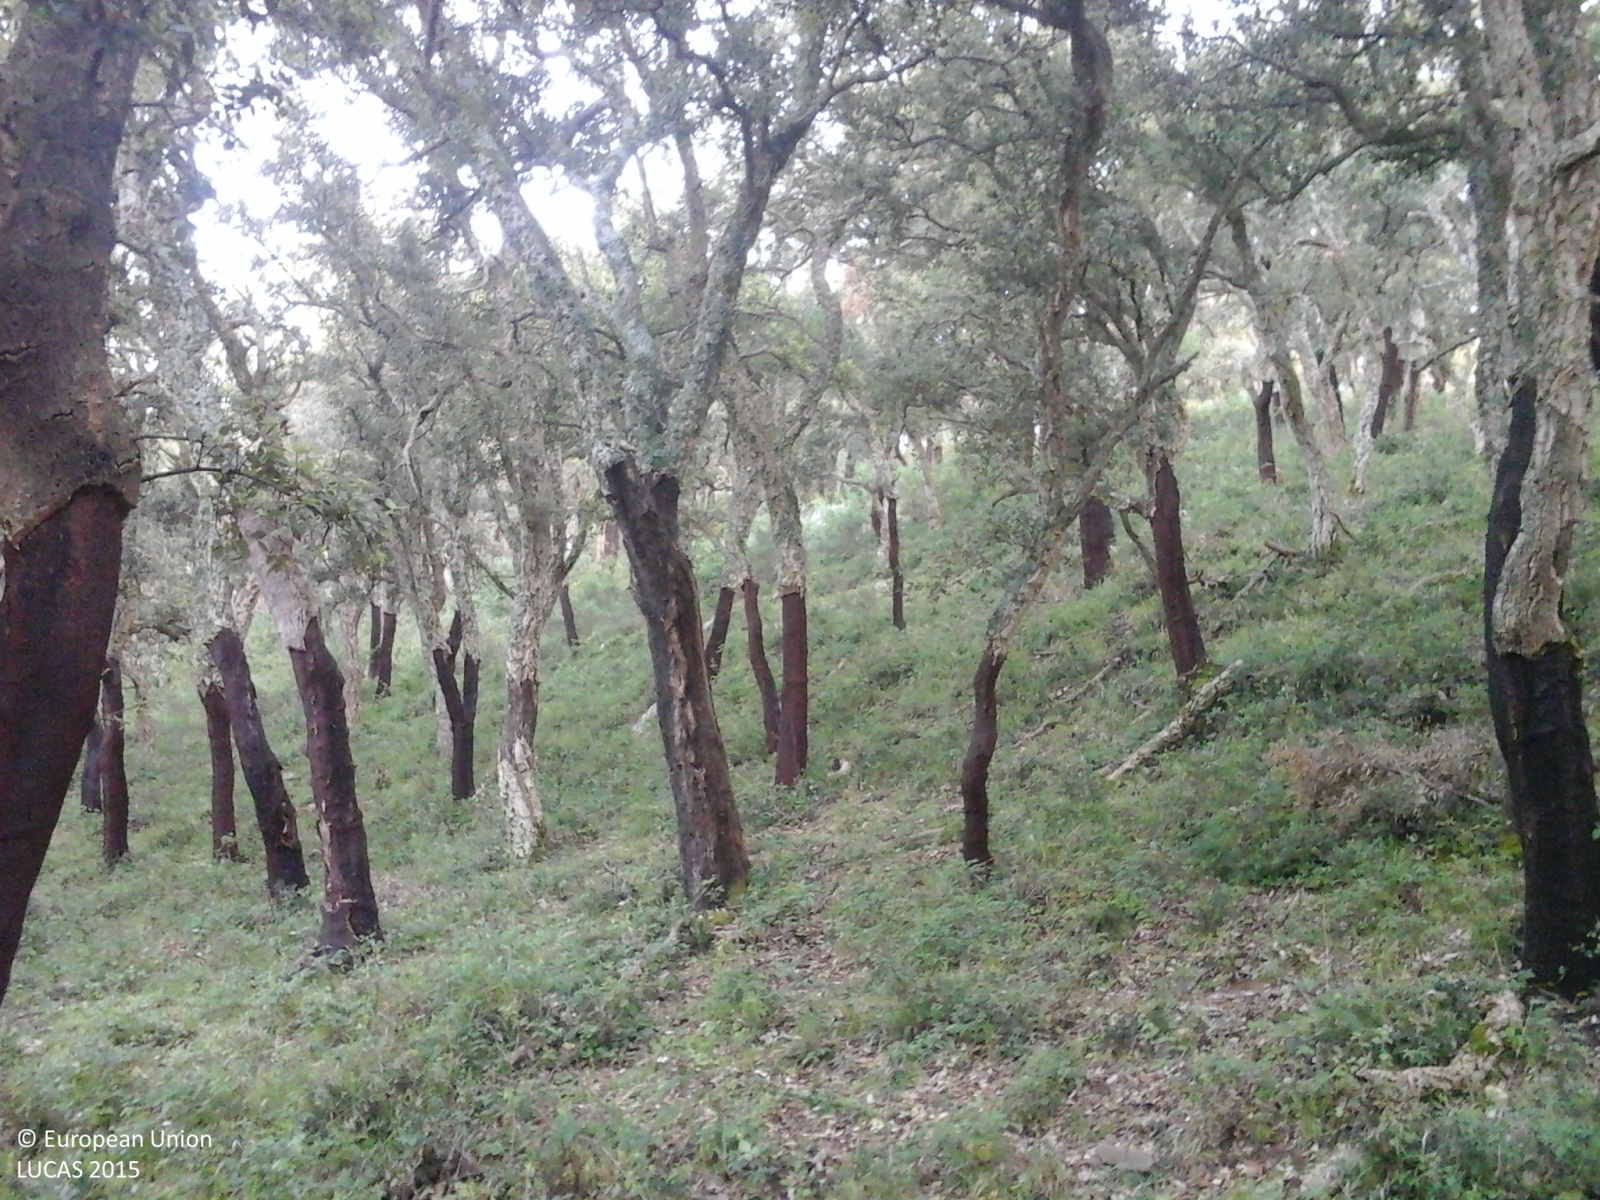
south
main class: Woodland
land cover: Broadleaved woodland
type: broadleaved evergreen forest
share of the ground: > 75 %
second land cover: Grassland without tree/shrub cover
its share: > 75 %
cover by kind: broadleaved forest trees 80 %, shrubs 10 %, herbaceous plants 5 %, consolidated bare surface 5 %
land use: Forestry
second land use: Agriculture (excluding fallow land and kitchen gardens)
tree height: > 5 m
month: May
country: IT
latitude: 37.8934
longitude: 14.1442
